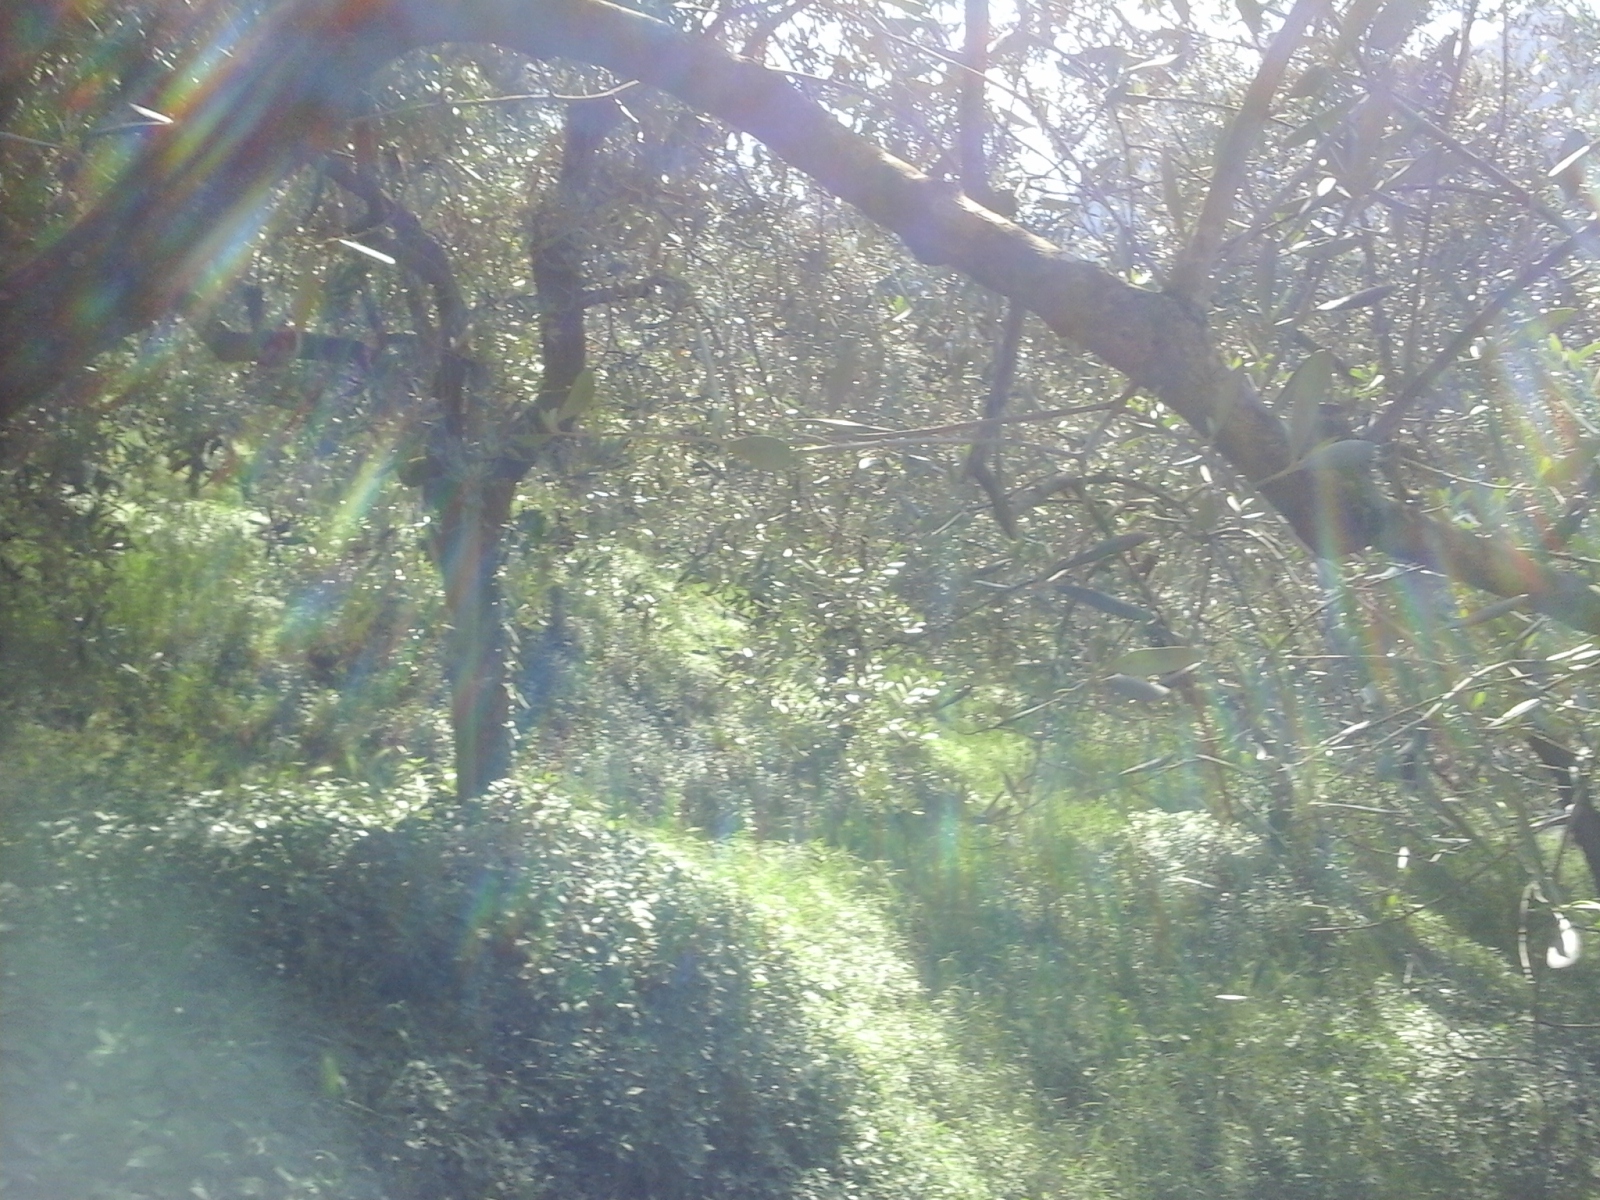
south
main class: Cropland
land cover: Olive groves
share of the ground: > 75 %
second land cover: Grassland without tree/shrub cover
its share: > 75 %
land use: Agriculture (excluding fallow land and kitchen gardens)
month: May
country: IT
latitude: 45.8793
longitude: 10.8619
